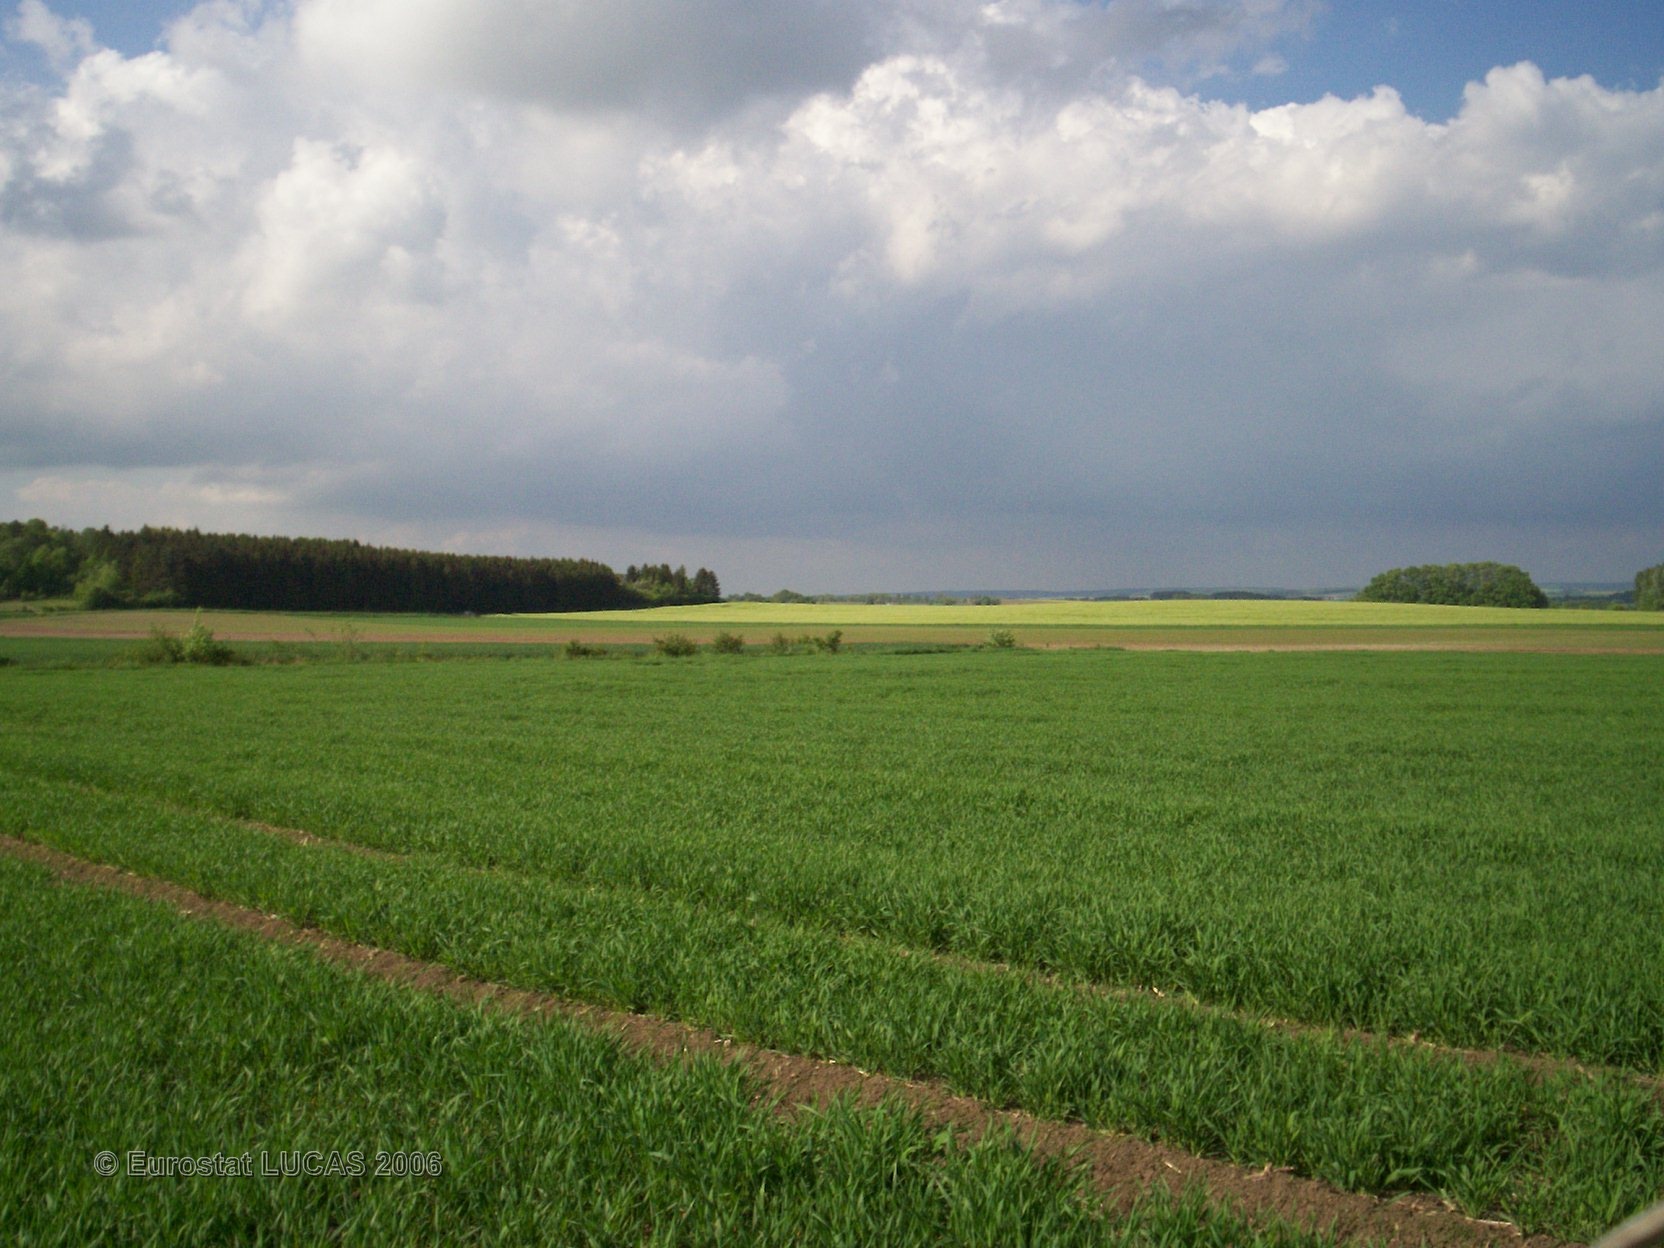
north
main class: Cropland
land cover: Barley
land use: Agriculture (excluding fallow land and kitchen gardens)
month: May
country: FR
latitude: 49.5584
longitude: 4.3693
